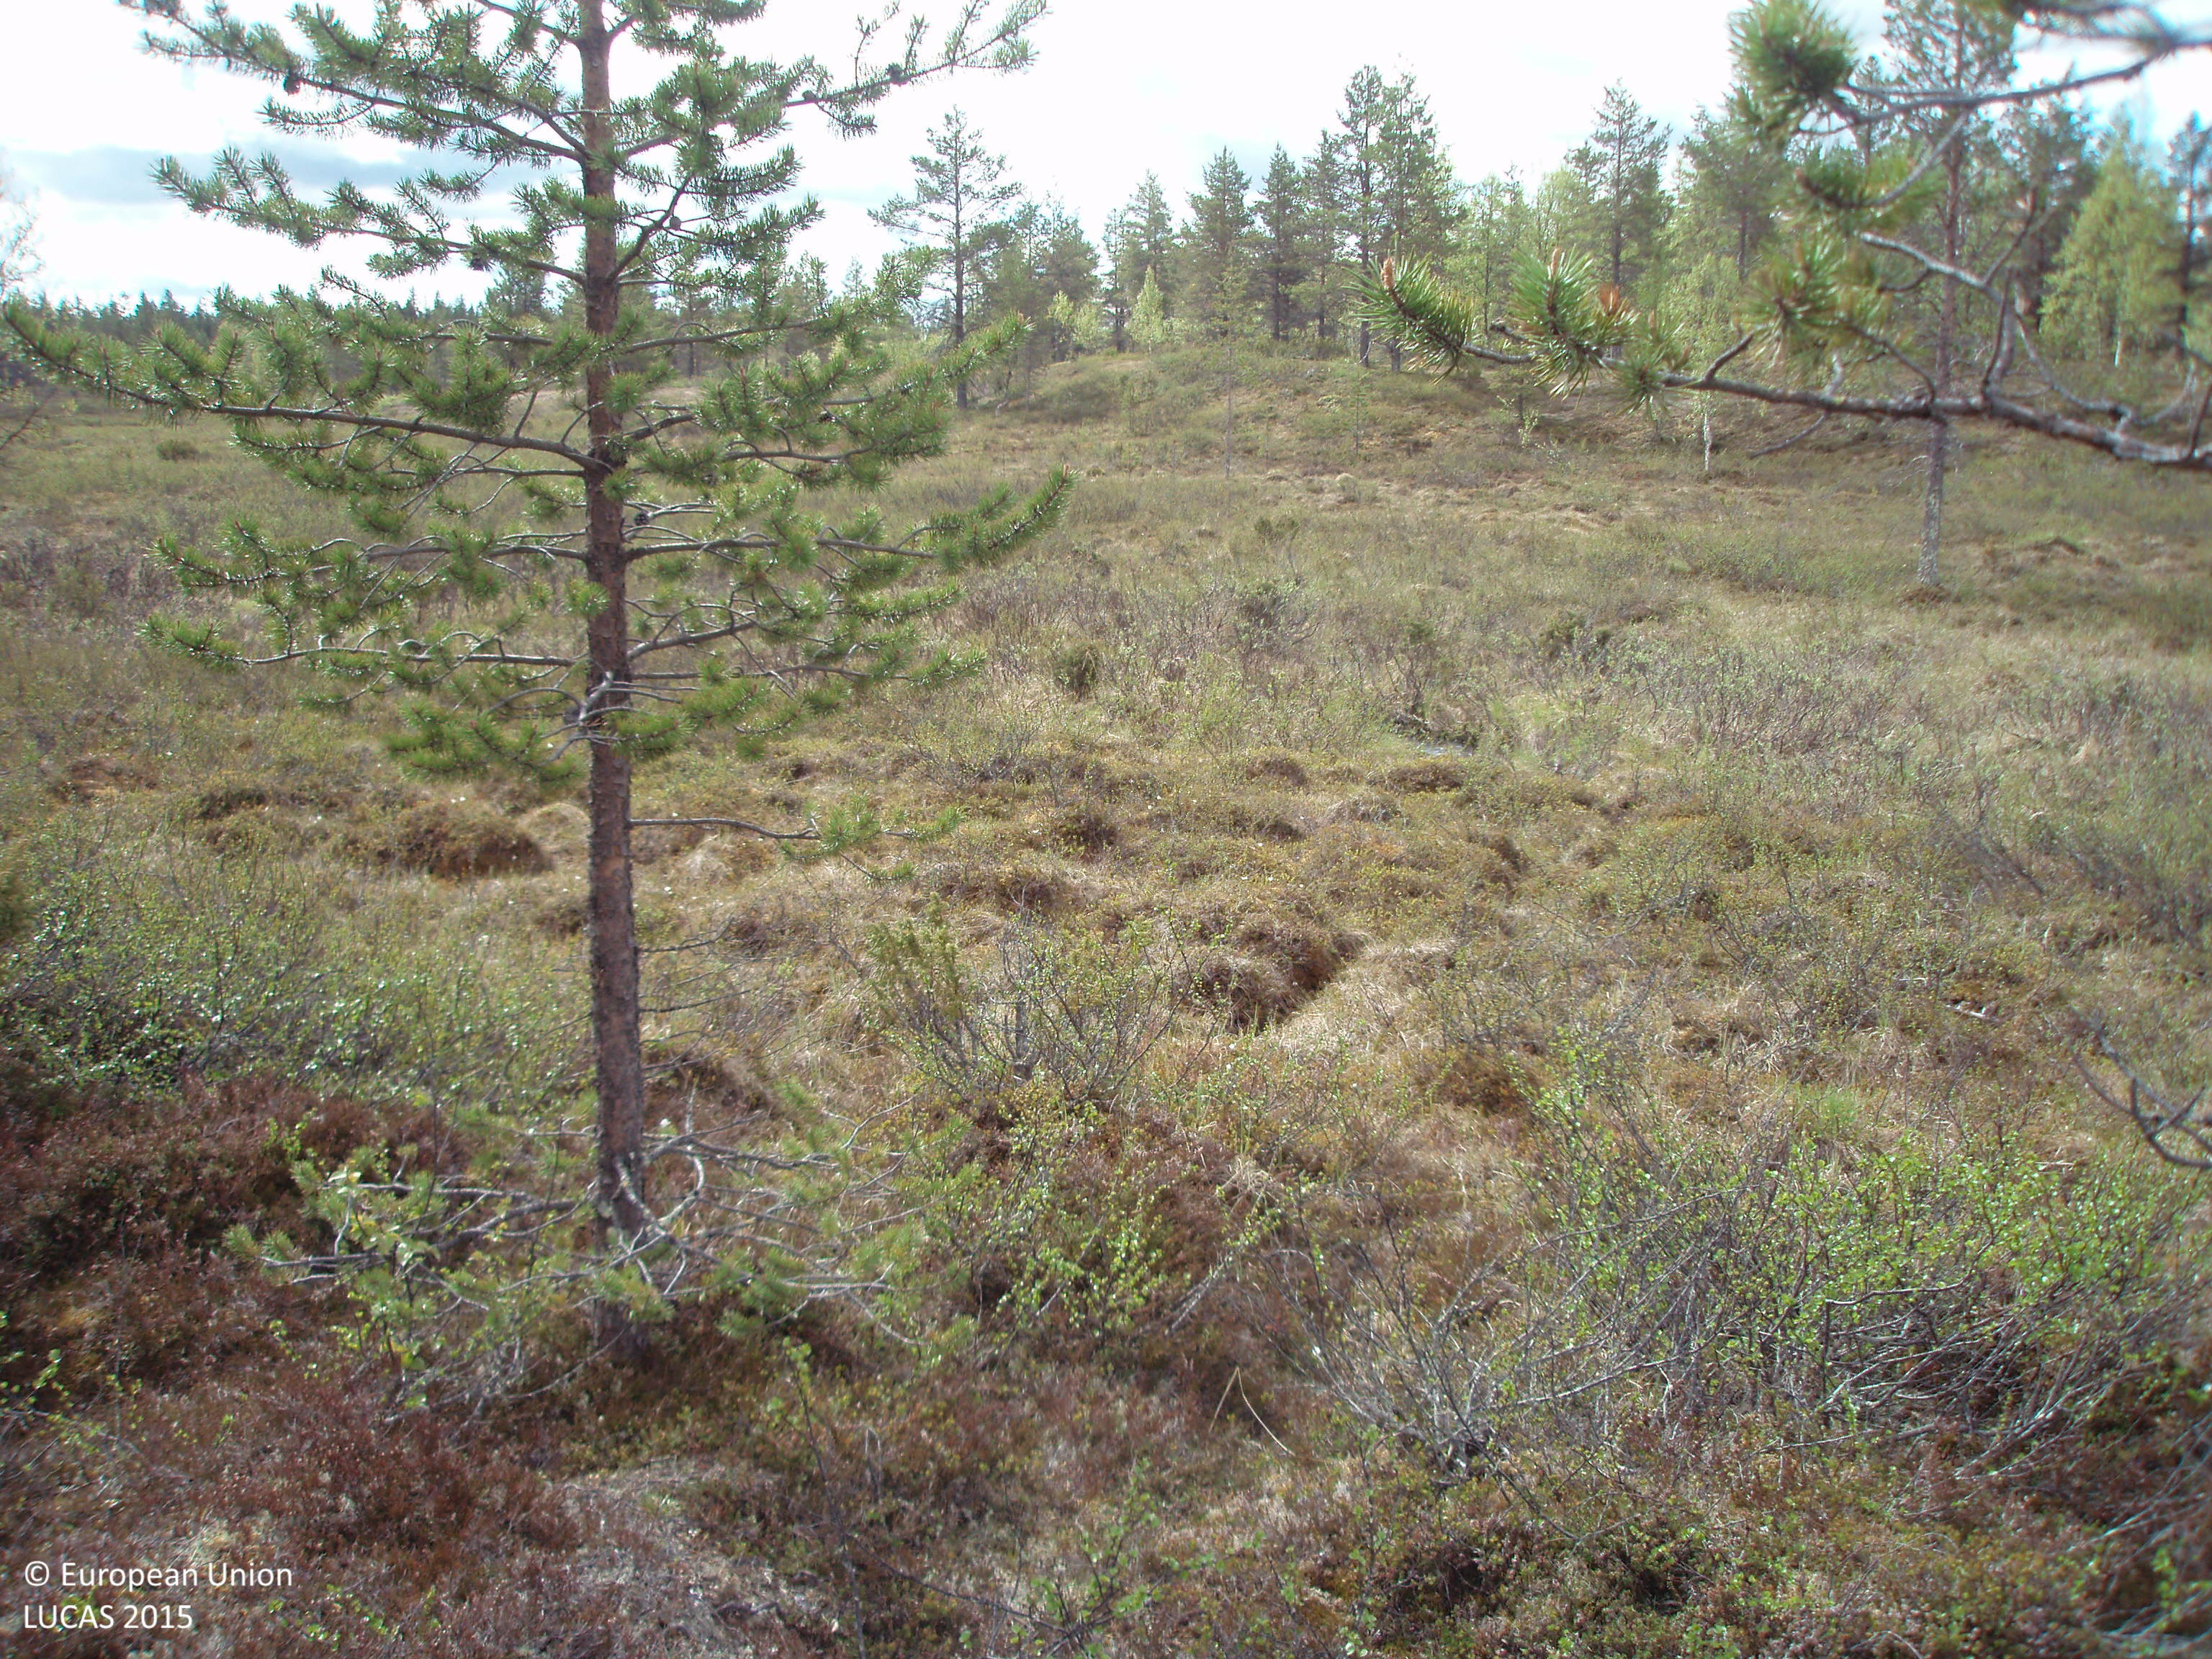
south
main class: Shrubland
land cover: Shrubland with sparse tree cover
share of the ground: > 75 %
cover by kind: shrubs 75 %, lichens and mosses 20 %, coniferous forest trees 5 %
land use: Semi-natural and natural areas not in use
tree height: > 5 m
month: June
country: FI
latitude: 68.3950
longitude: 26.9318
